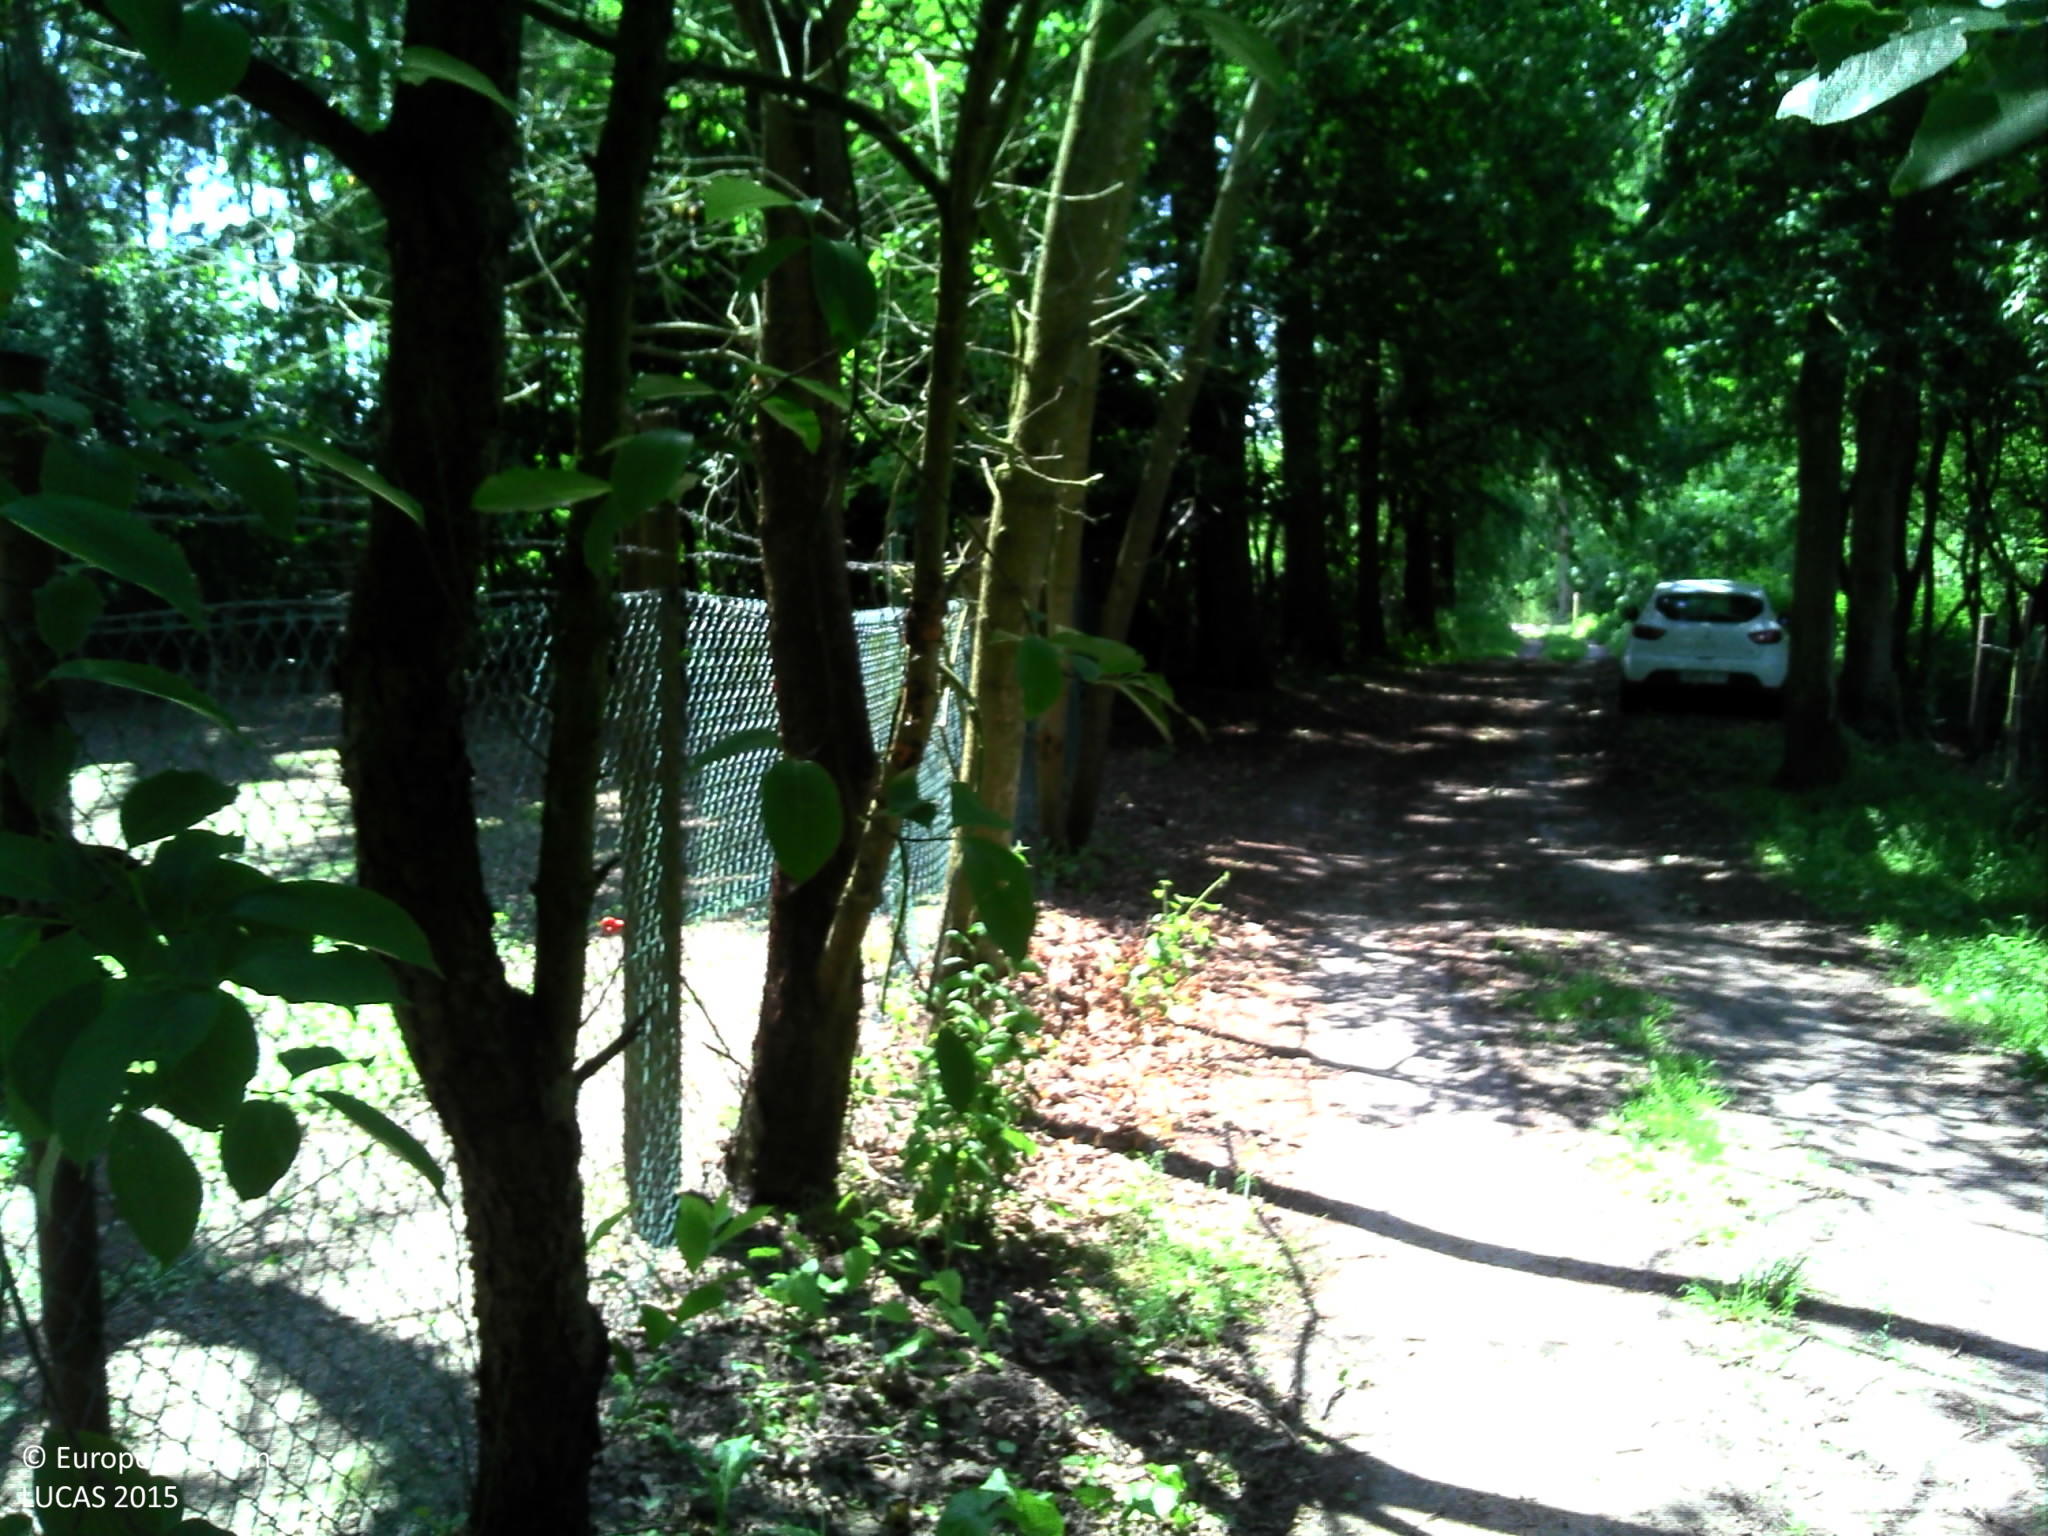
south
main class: Woodland
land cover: Broadleaved woodland
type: mesophytic deciduous forest
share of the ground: > 75 %
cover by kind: broadleaved forest trees 100 %
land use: Forestry
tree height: > 5 m
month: June
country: BE
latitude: 51.0175
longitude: 3.9927
